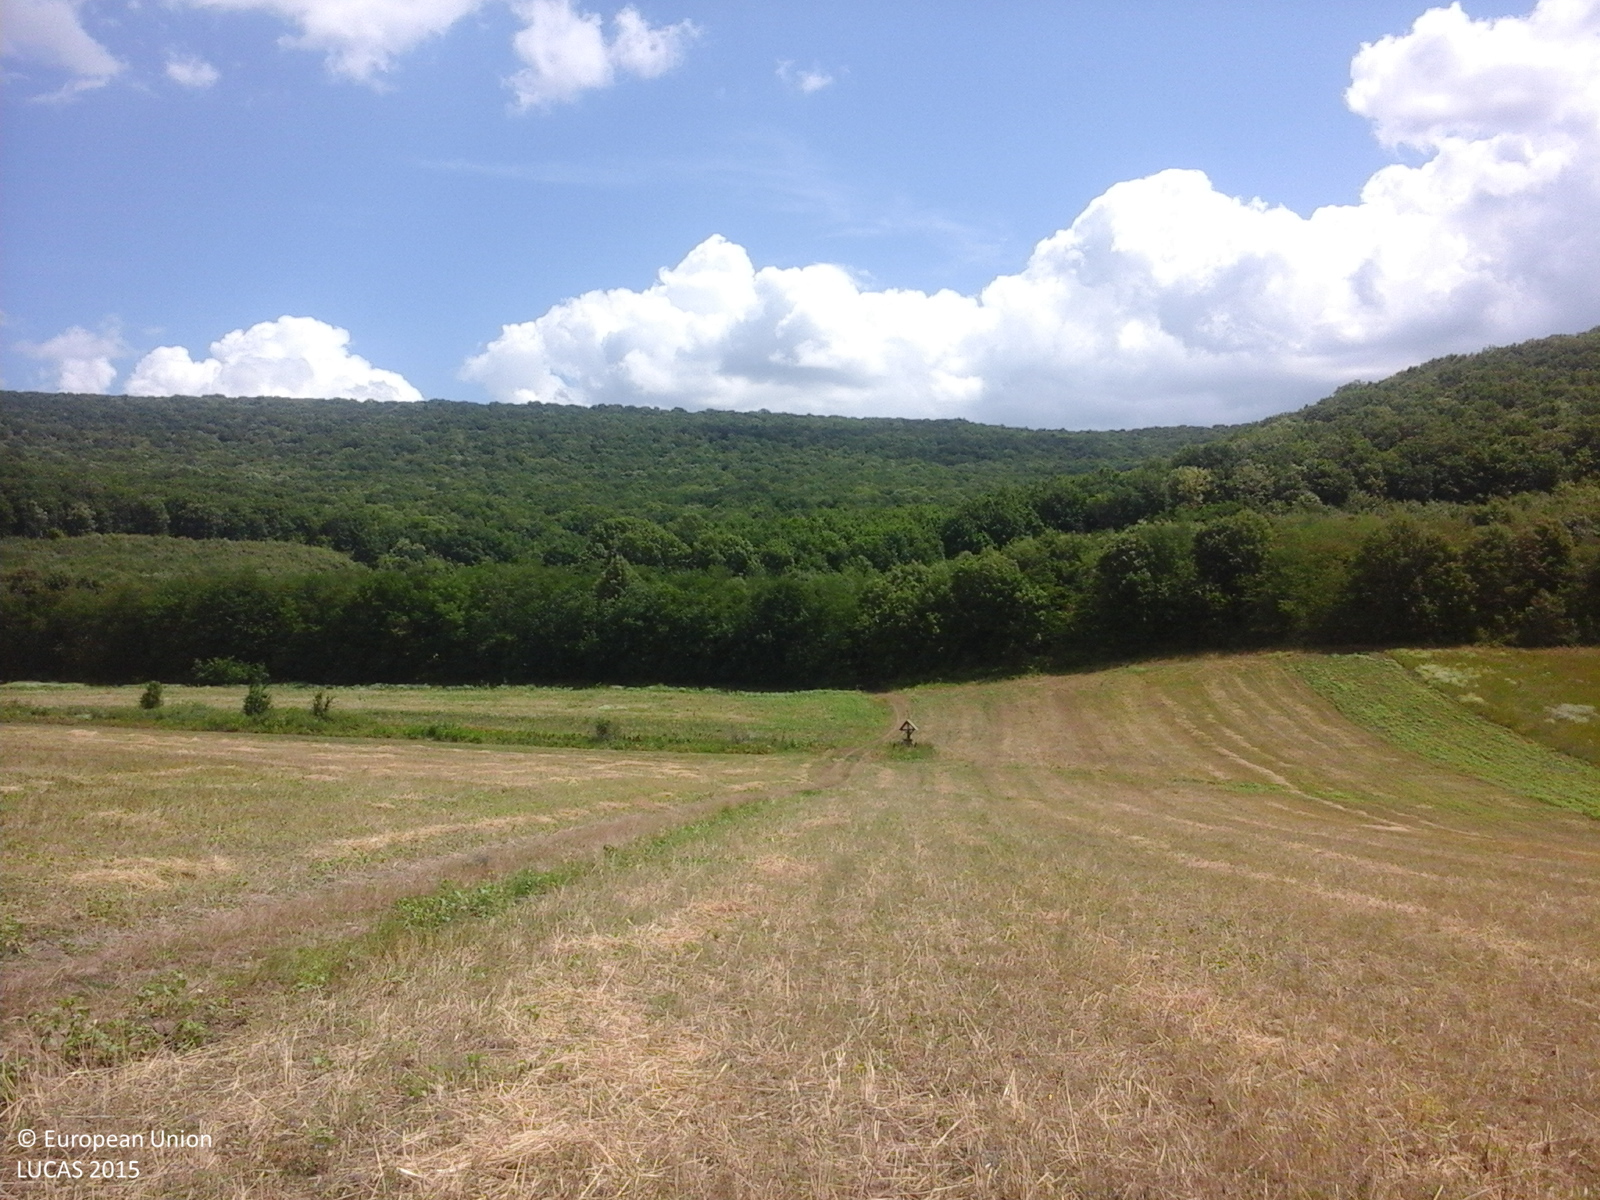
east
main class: Cropland
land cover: Common wheat
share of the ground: > 75 %
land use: Agriculture (excluding fallow land and kitchen gardens)
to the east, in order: Common wheat; Grass margins; Tracks; Common wheat; Ditches and canals; Spontaneously vegetated surfaces; Broadleaved woodland; Tracks
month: July
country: RO
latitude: 46.4205
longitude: 27.3991
